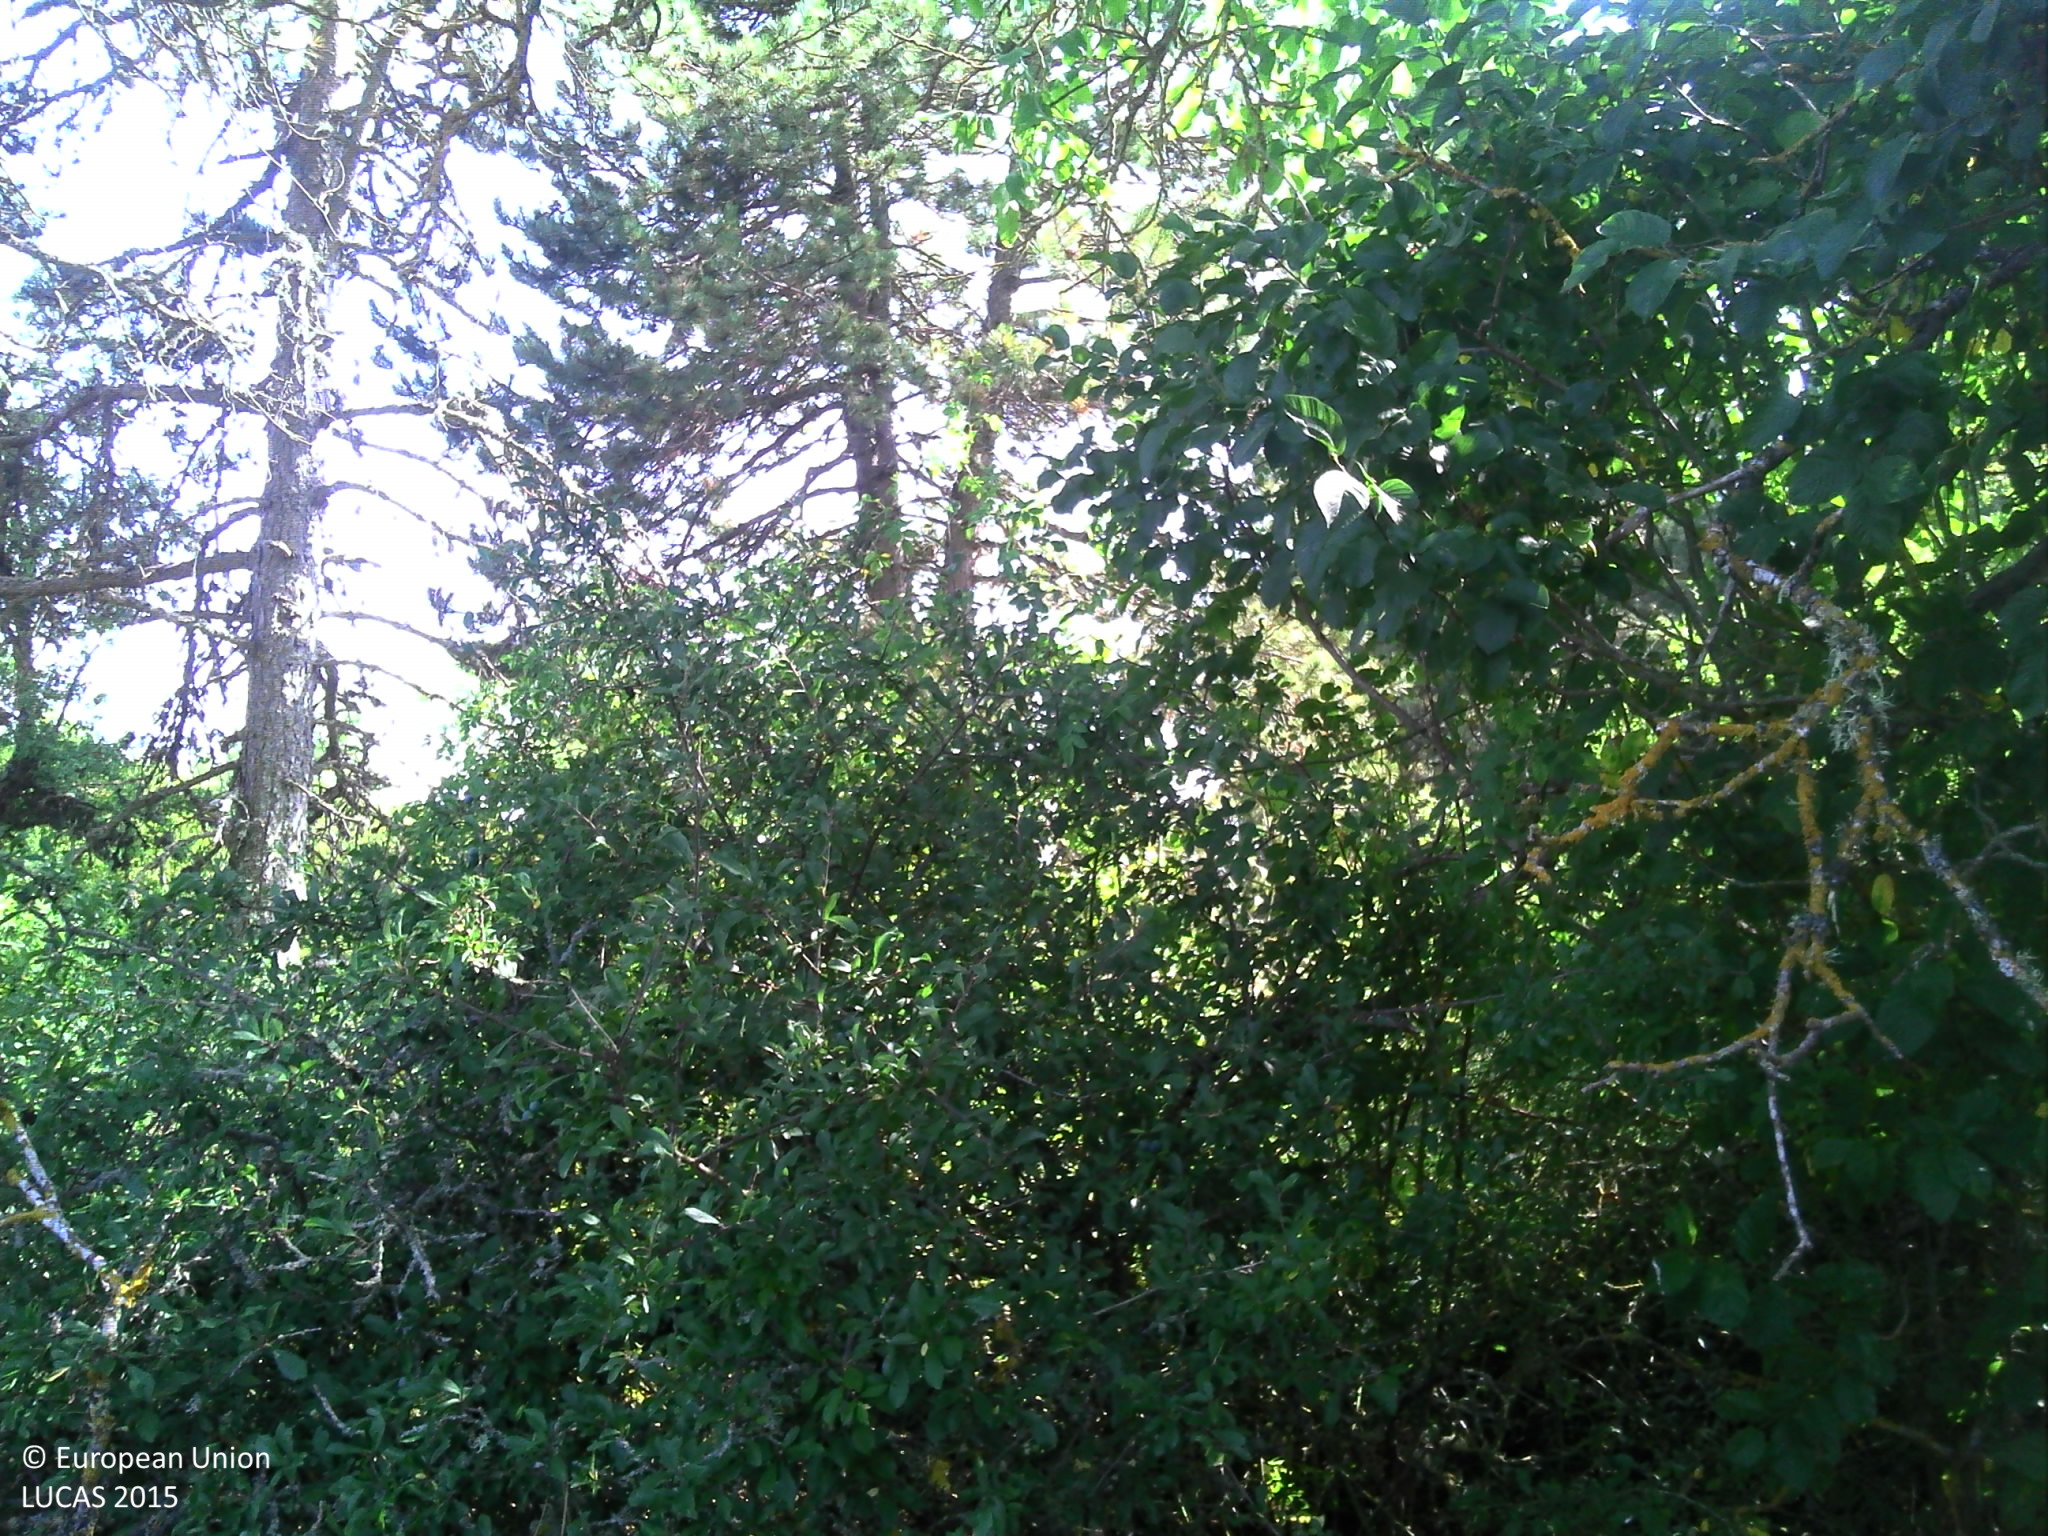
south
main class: Woodland
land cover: Pine dominated coniferous woodland
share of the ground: > 75 %
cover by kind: coniferous forest trees 95 %, broadleaved forest trees 5 %
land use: Agriculture (excluding fallow land and kitchen gardens)
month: July
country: FR
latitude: 44.3618
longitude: 3.4685
